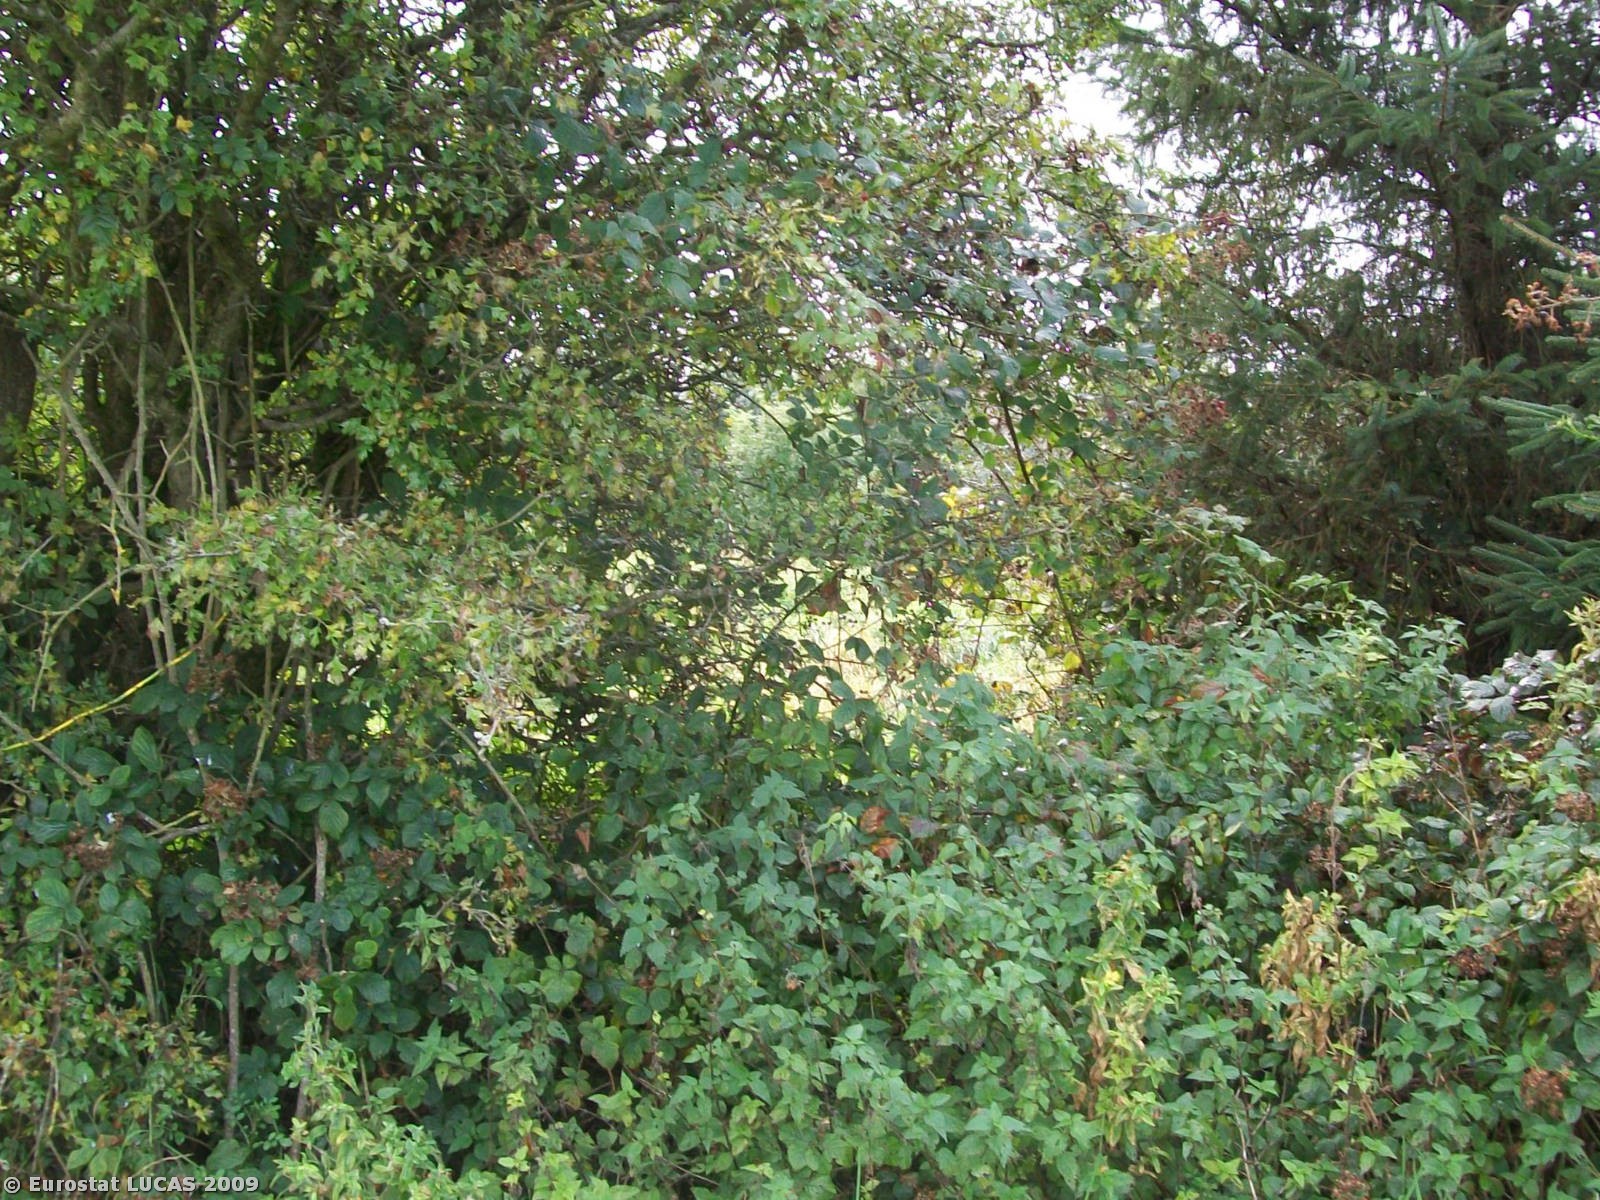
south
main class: Woodland
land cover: Coniferous woodland
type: plantations and self-sown exotic forest
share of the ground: > 75 %
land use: Forestry
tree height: > 5 m
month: September
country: IE
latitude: 53.1507
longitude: -7.9527
